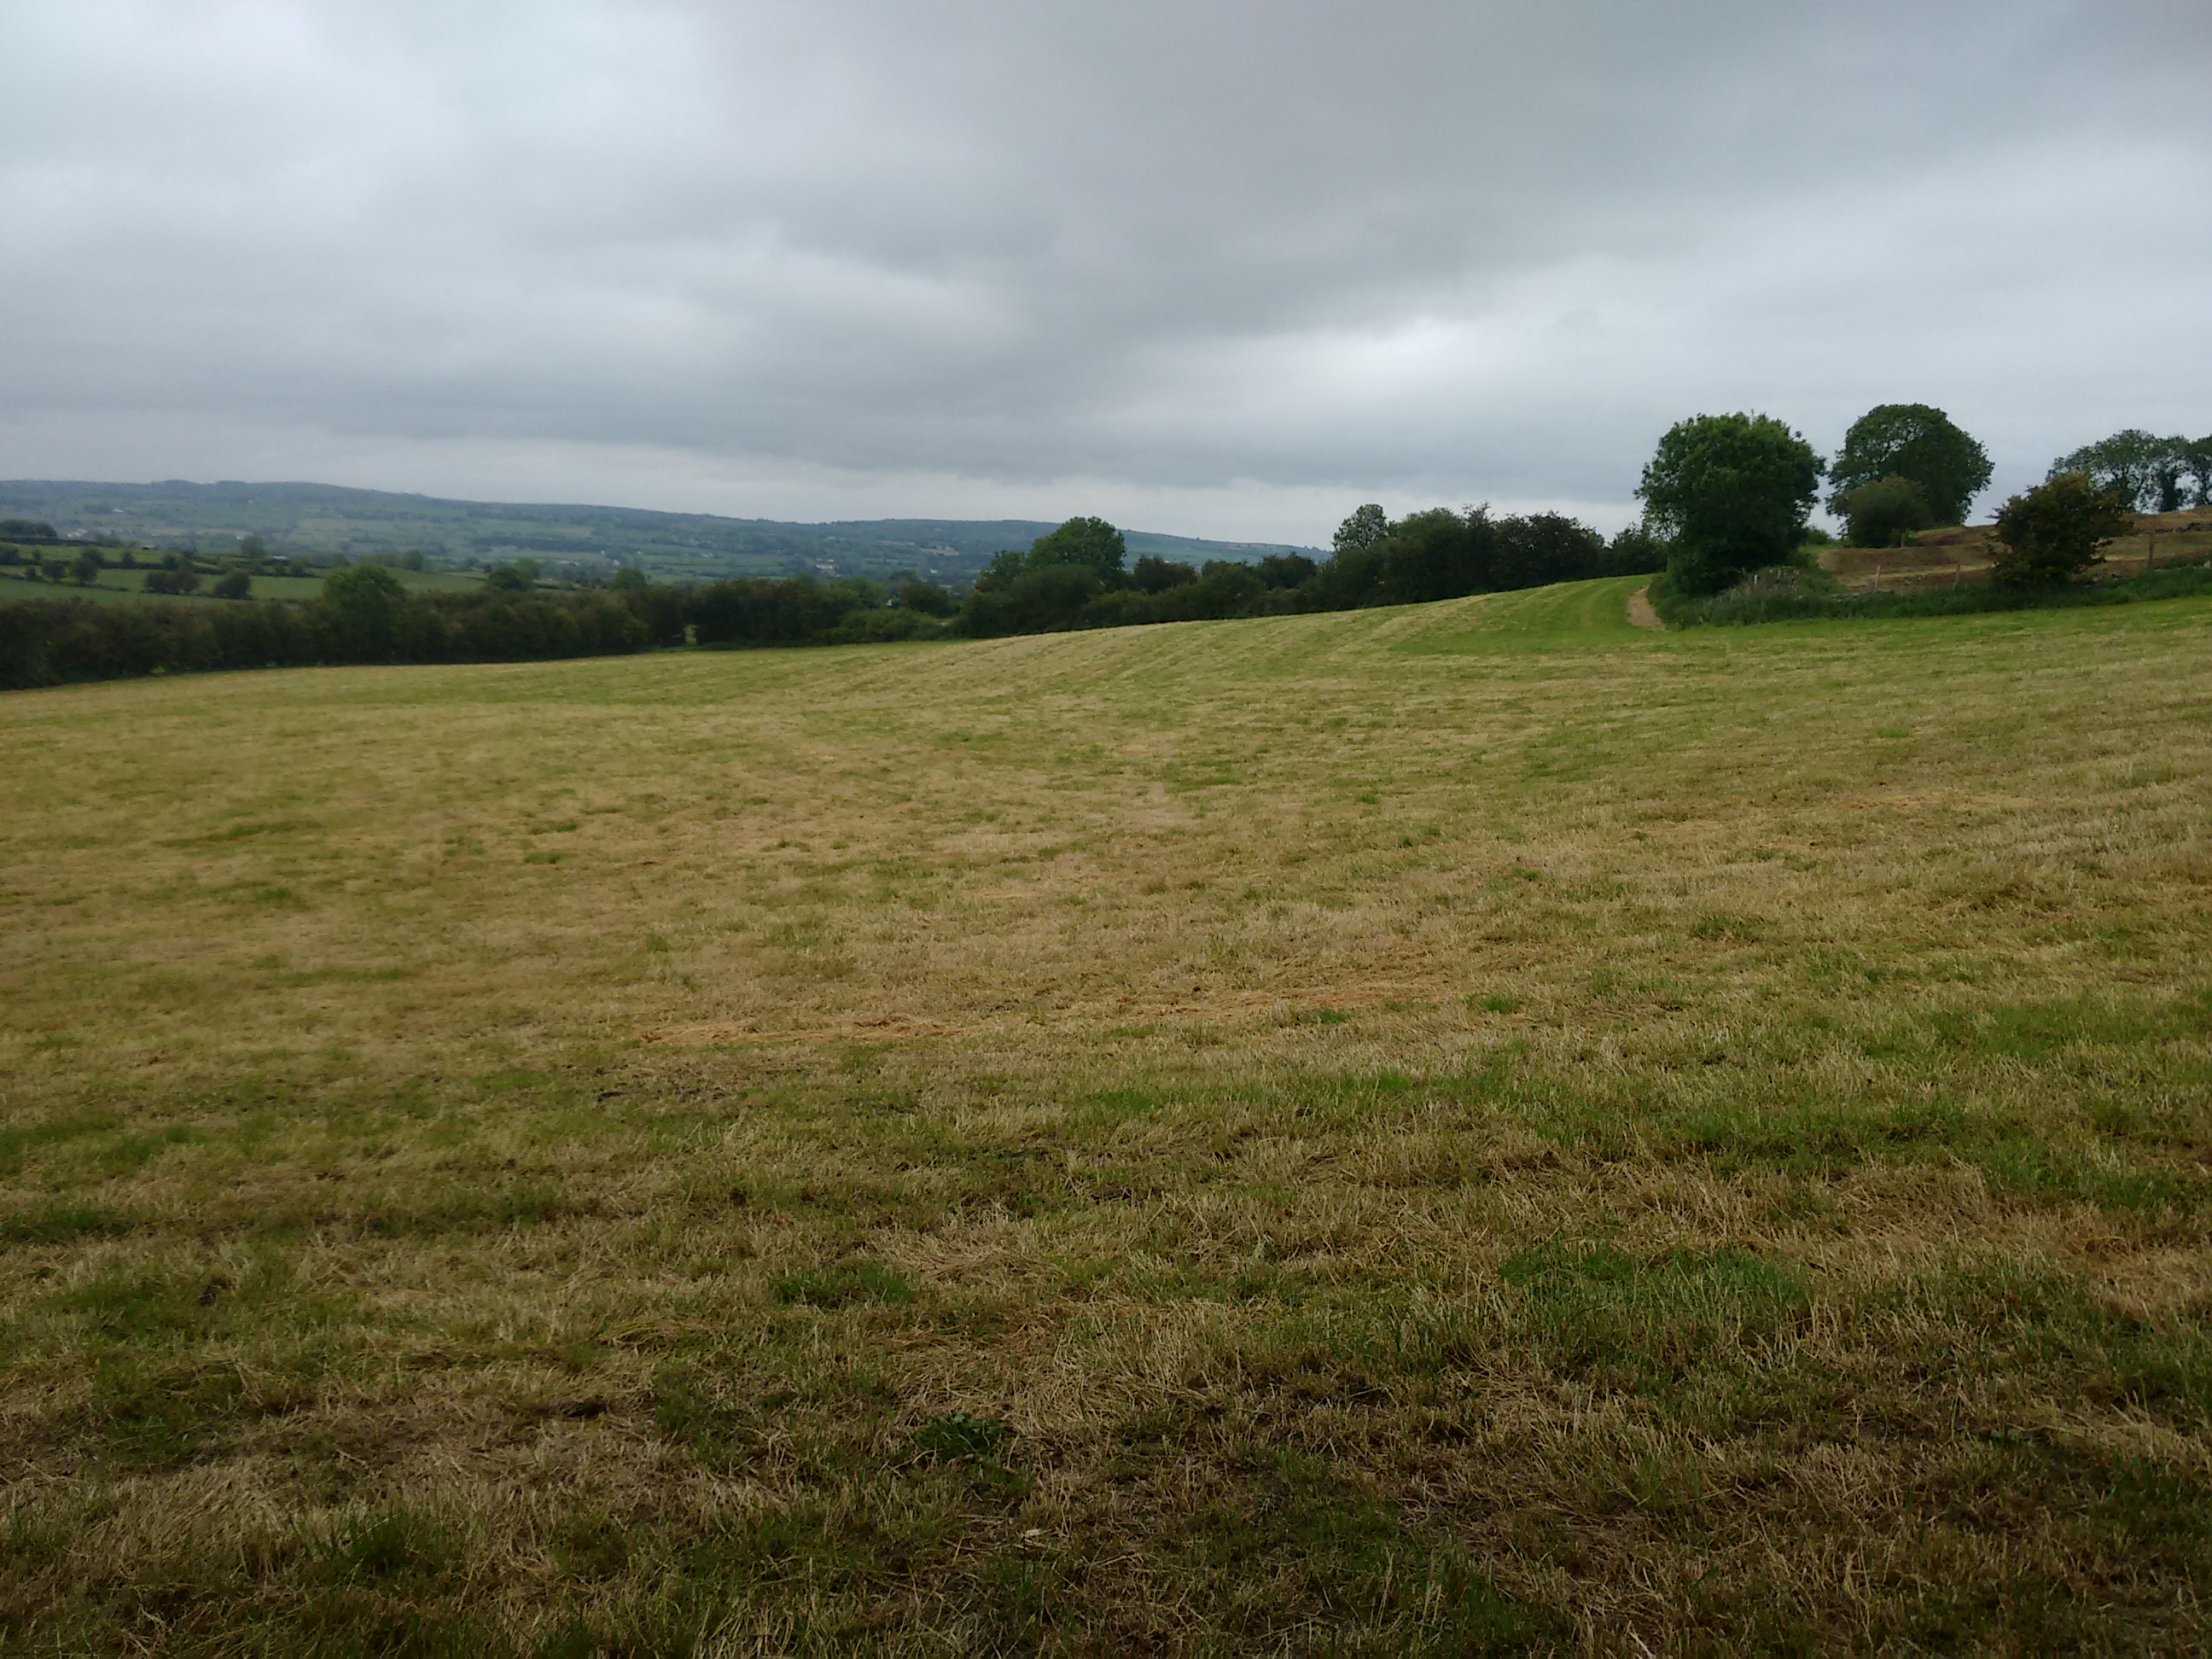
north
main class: Grassland
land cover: Grassland without tree/shrub cover
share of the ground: > 75 %
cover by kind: herbaceous plants 100 %
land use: Agriculture (excluding fallow land and kitchen gardens)
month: June
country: GB
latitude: 54.6913
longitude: -7.5159
